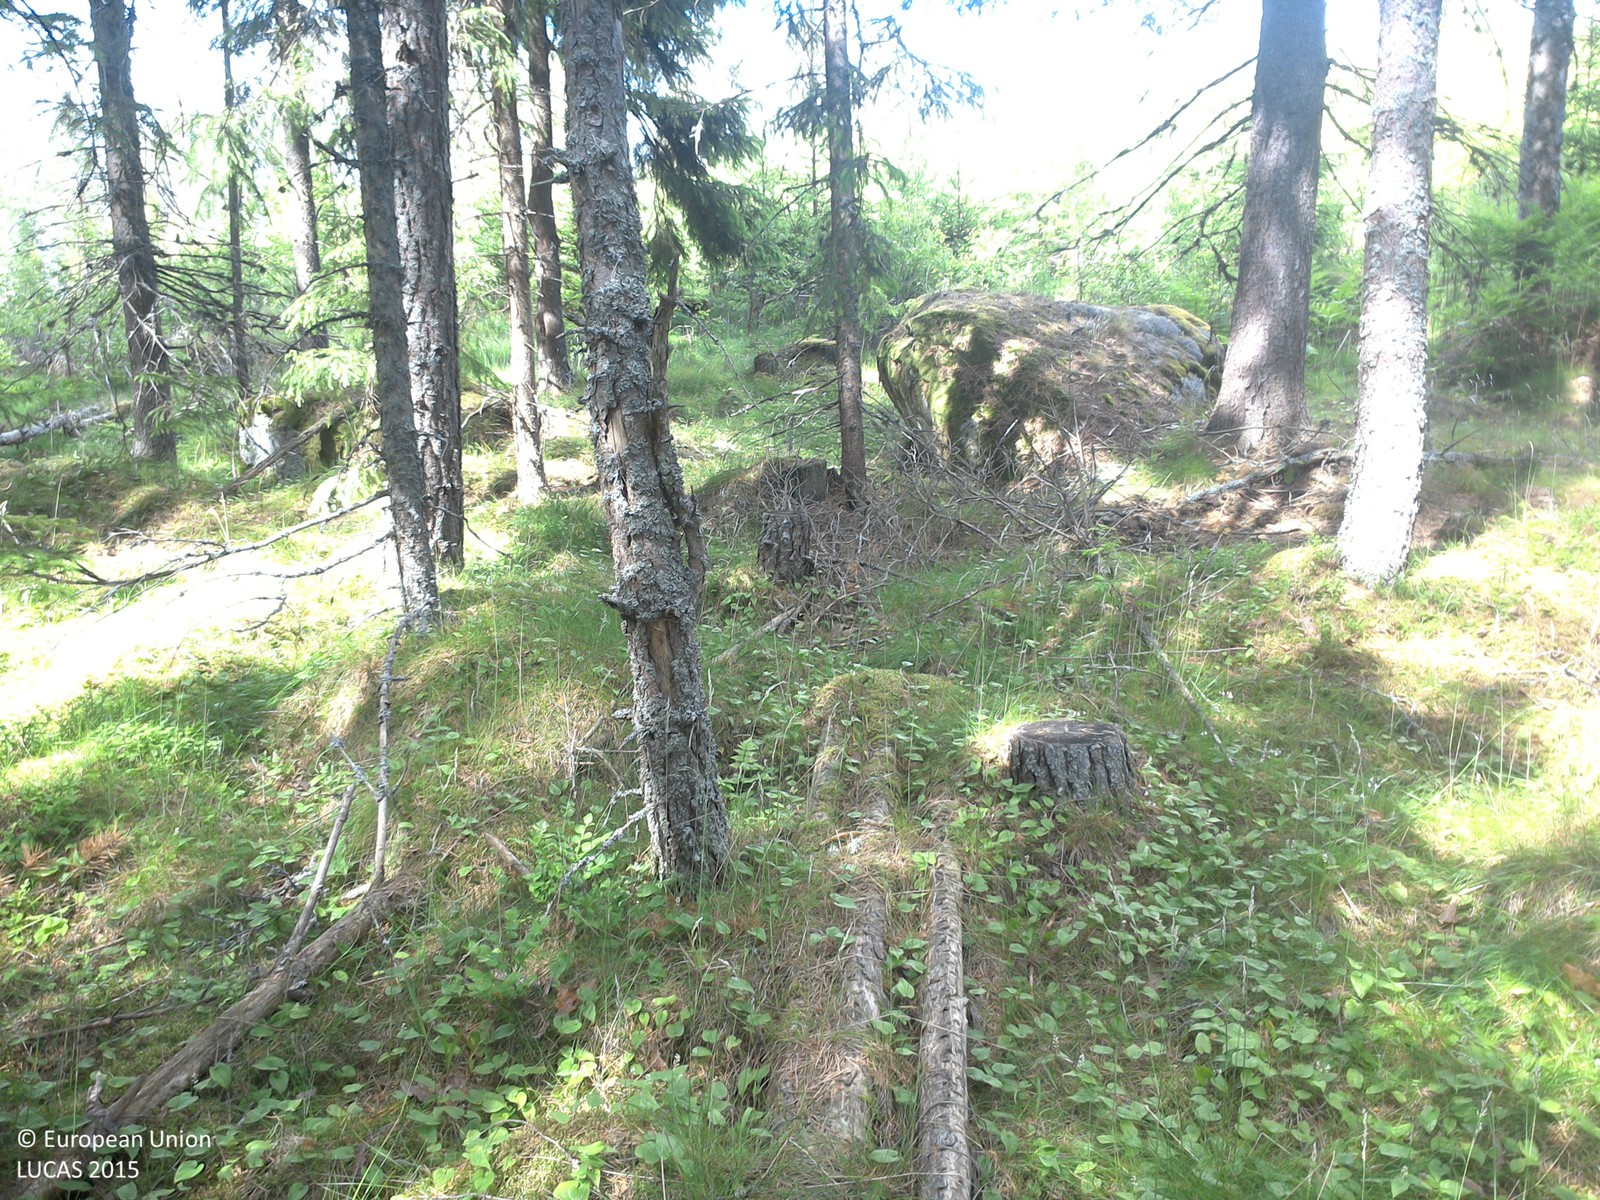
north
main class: Woodland
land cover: Pine dominated coniferous woodland
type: boreal forest
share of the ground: 50 - 75 %
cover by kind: coniferous forest trees 65 %, lichens and mosses 30 %, herbaceous plants 5 %
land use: Forestry
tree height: > 5 m
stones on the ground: < 10 %
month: June
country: SE
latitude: 58.0528
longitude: 15.5023
